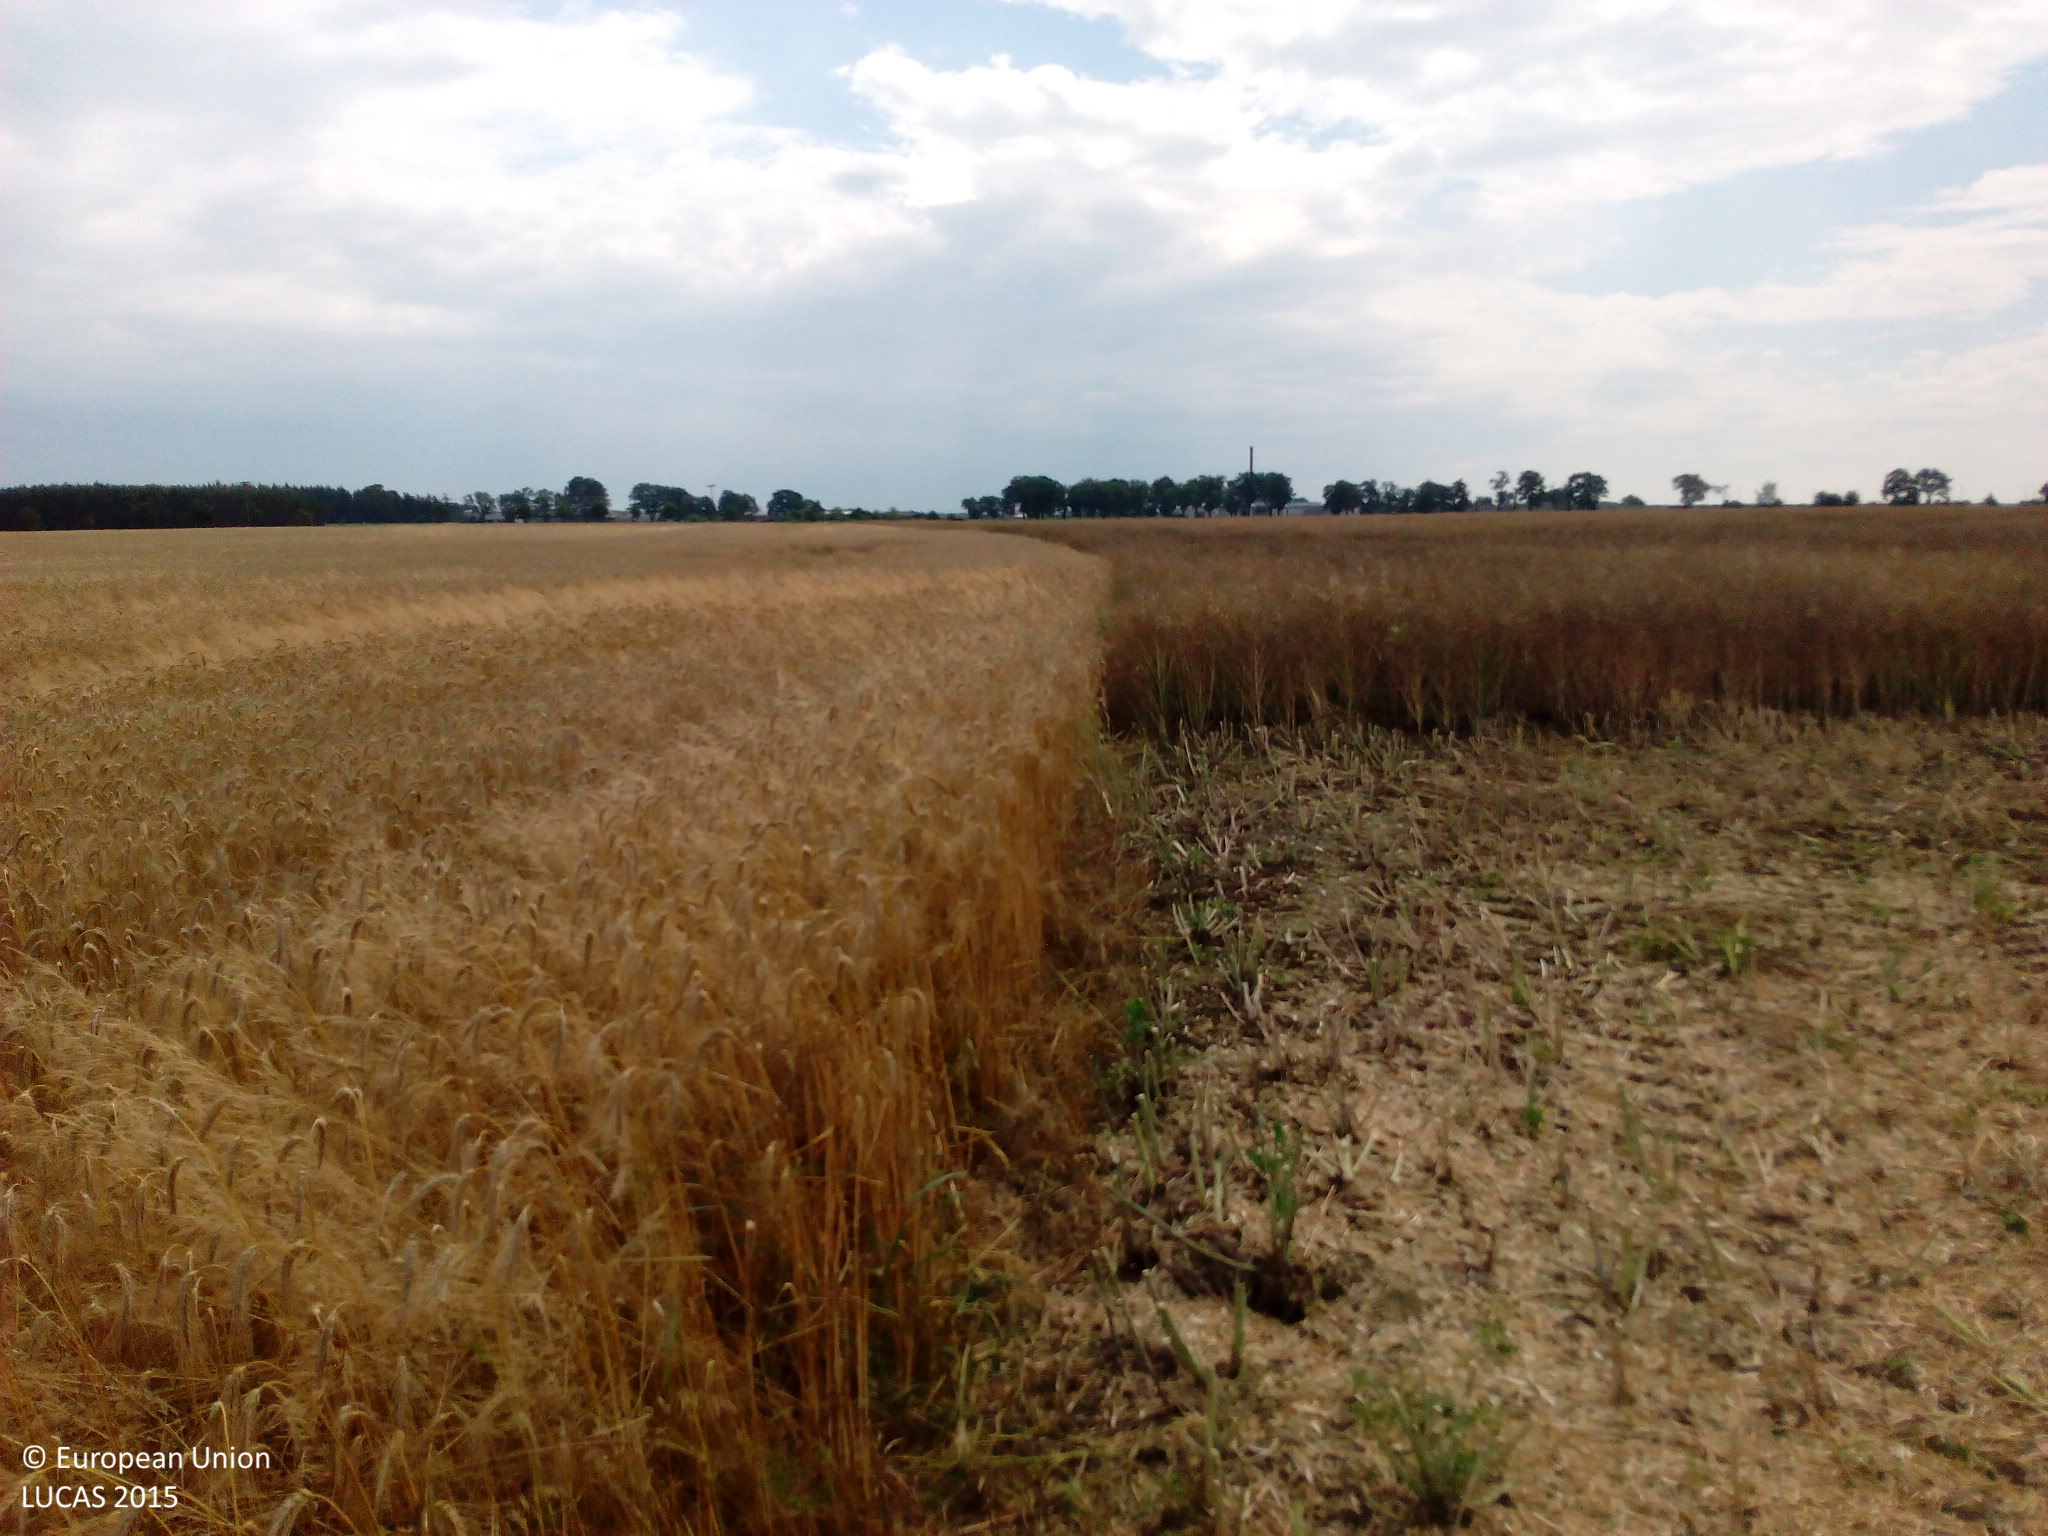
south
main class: Cropland
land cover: Rye
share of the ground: > 75 %
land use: Agriculture (excluding fallow land and kitchen gardens)
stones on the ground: < 10 %
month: July
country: DE
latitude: 52.2701
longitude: 12.0365
